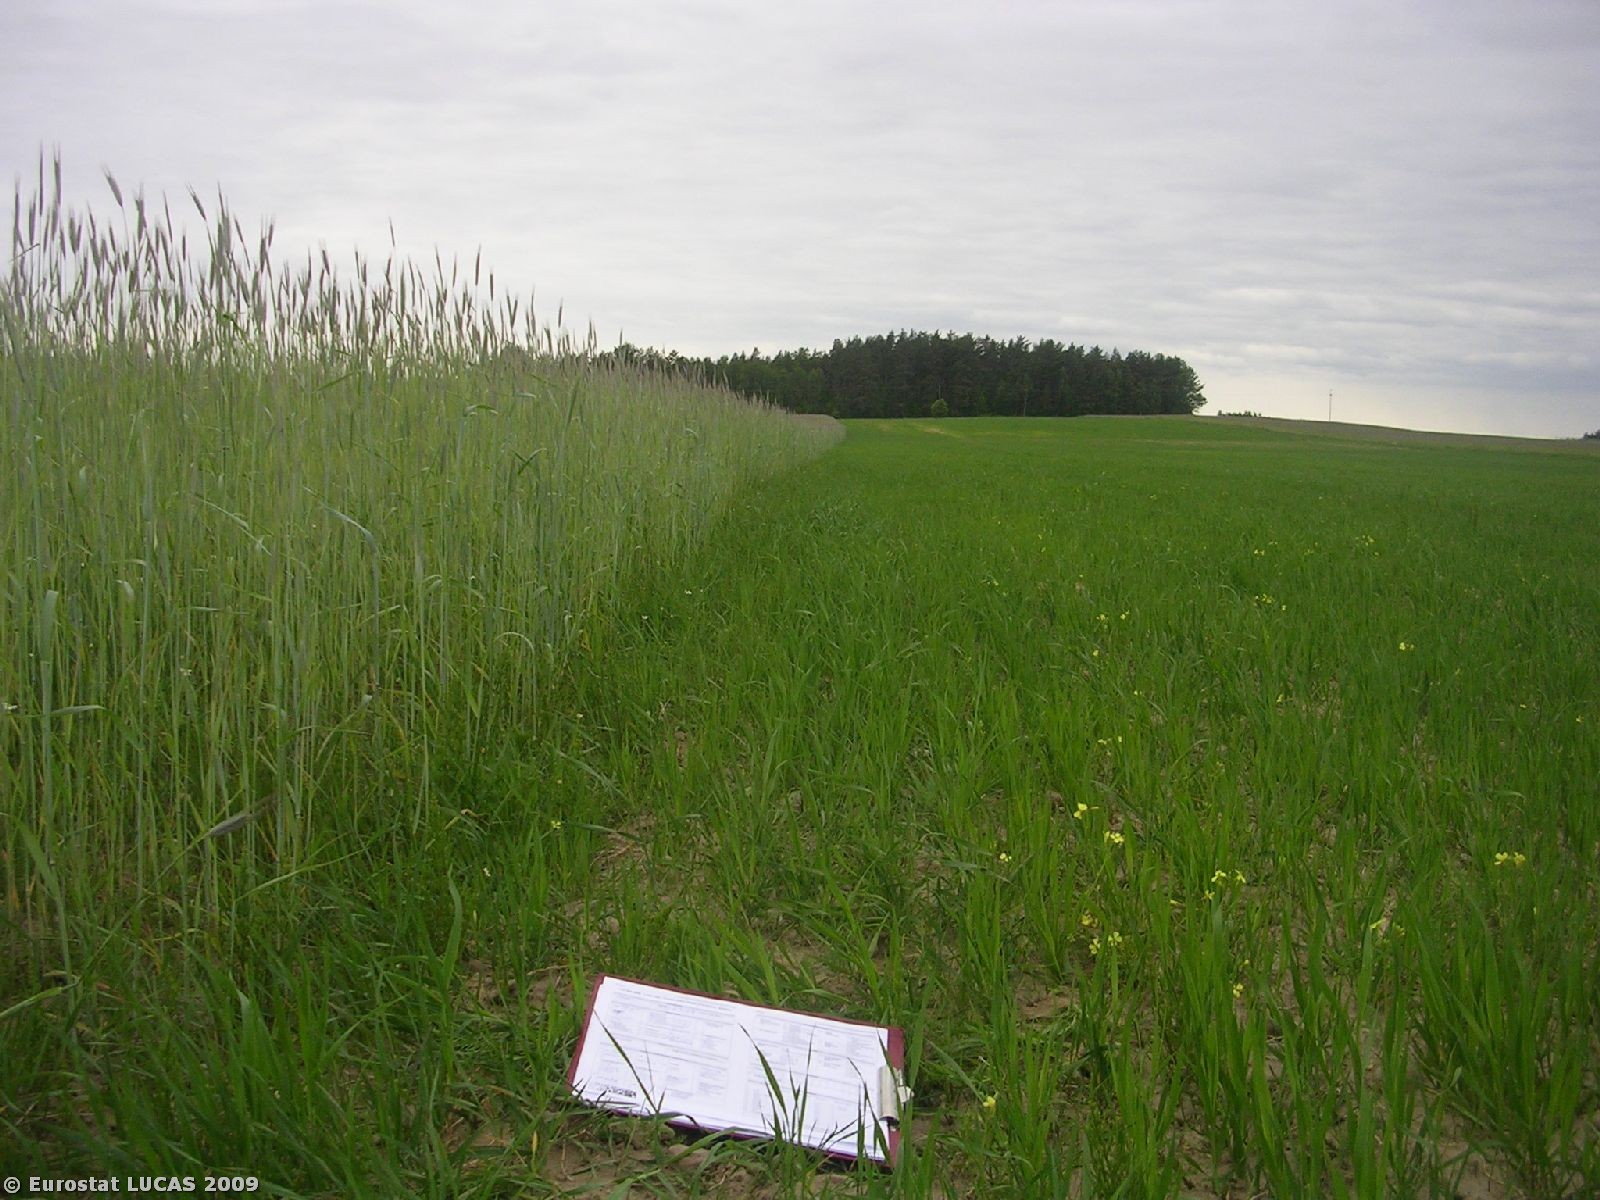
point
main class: Cropland
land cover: Barley
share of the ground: 25 - 50 %
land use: Agriculture (excluding fallow land and kitchen gardens)
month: May
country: PL
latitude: 53.5742
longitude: 23.4784
